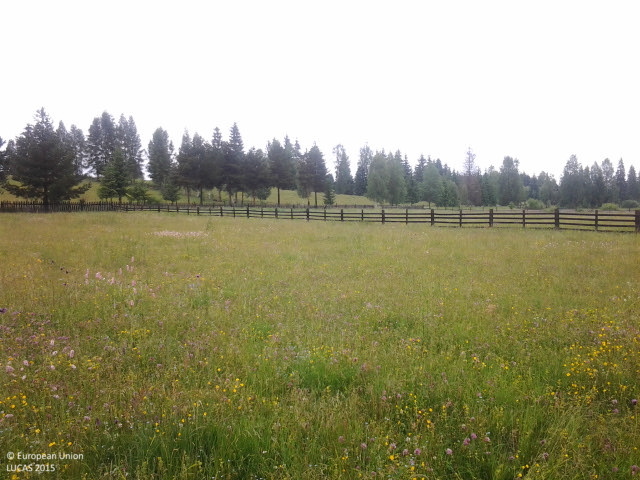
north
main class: Grassland
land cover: Grassland without tree/shrub cover
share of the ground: > 75 %
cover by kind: herbaceous plants 100 %
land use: Agriculture (excluding fallow land and kitchen gardens)
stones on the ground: < 10 %
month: June
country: RO
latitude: 47.2507
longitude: 25.3452
